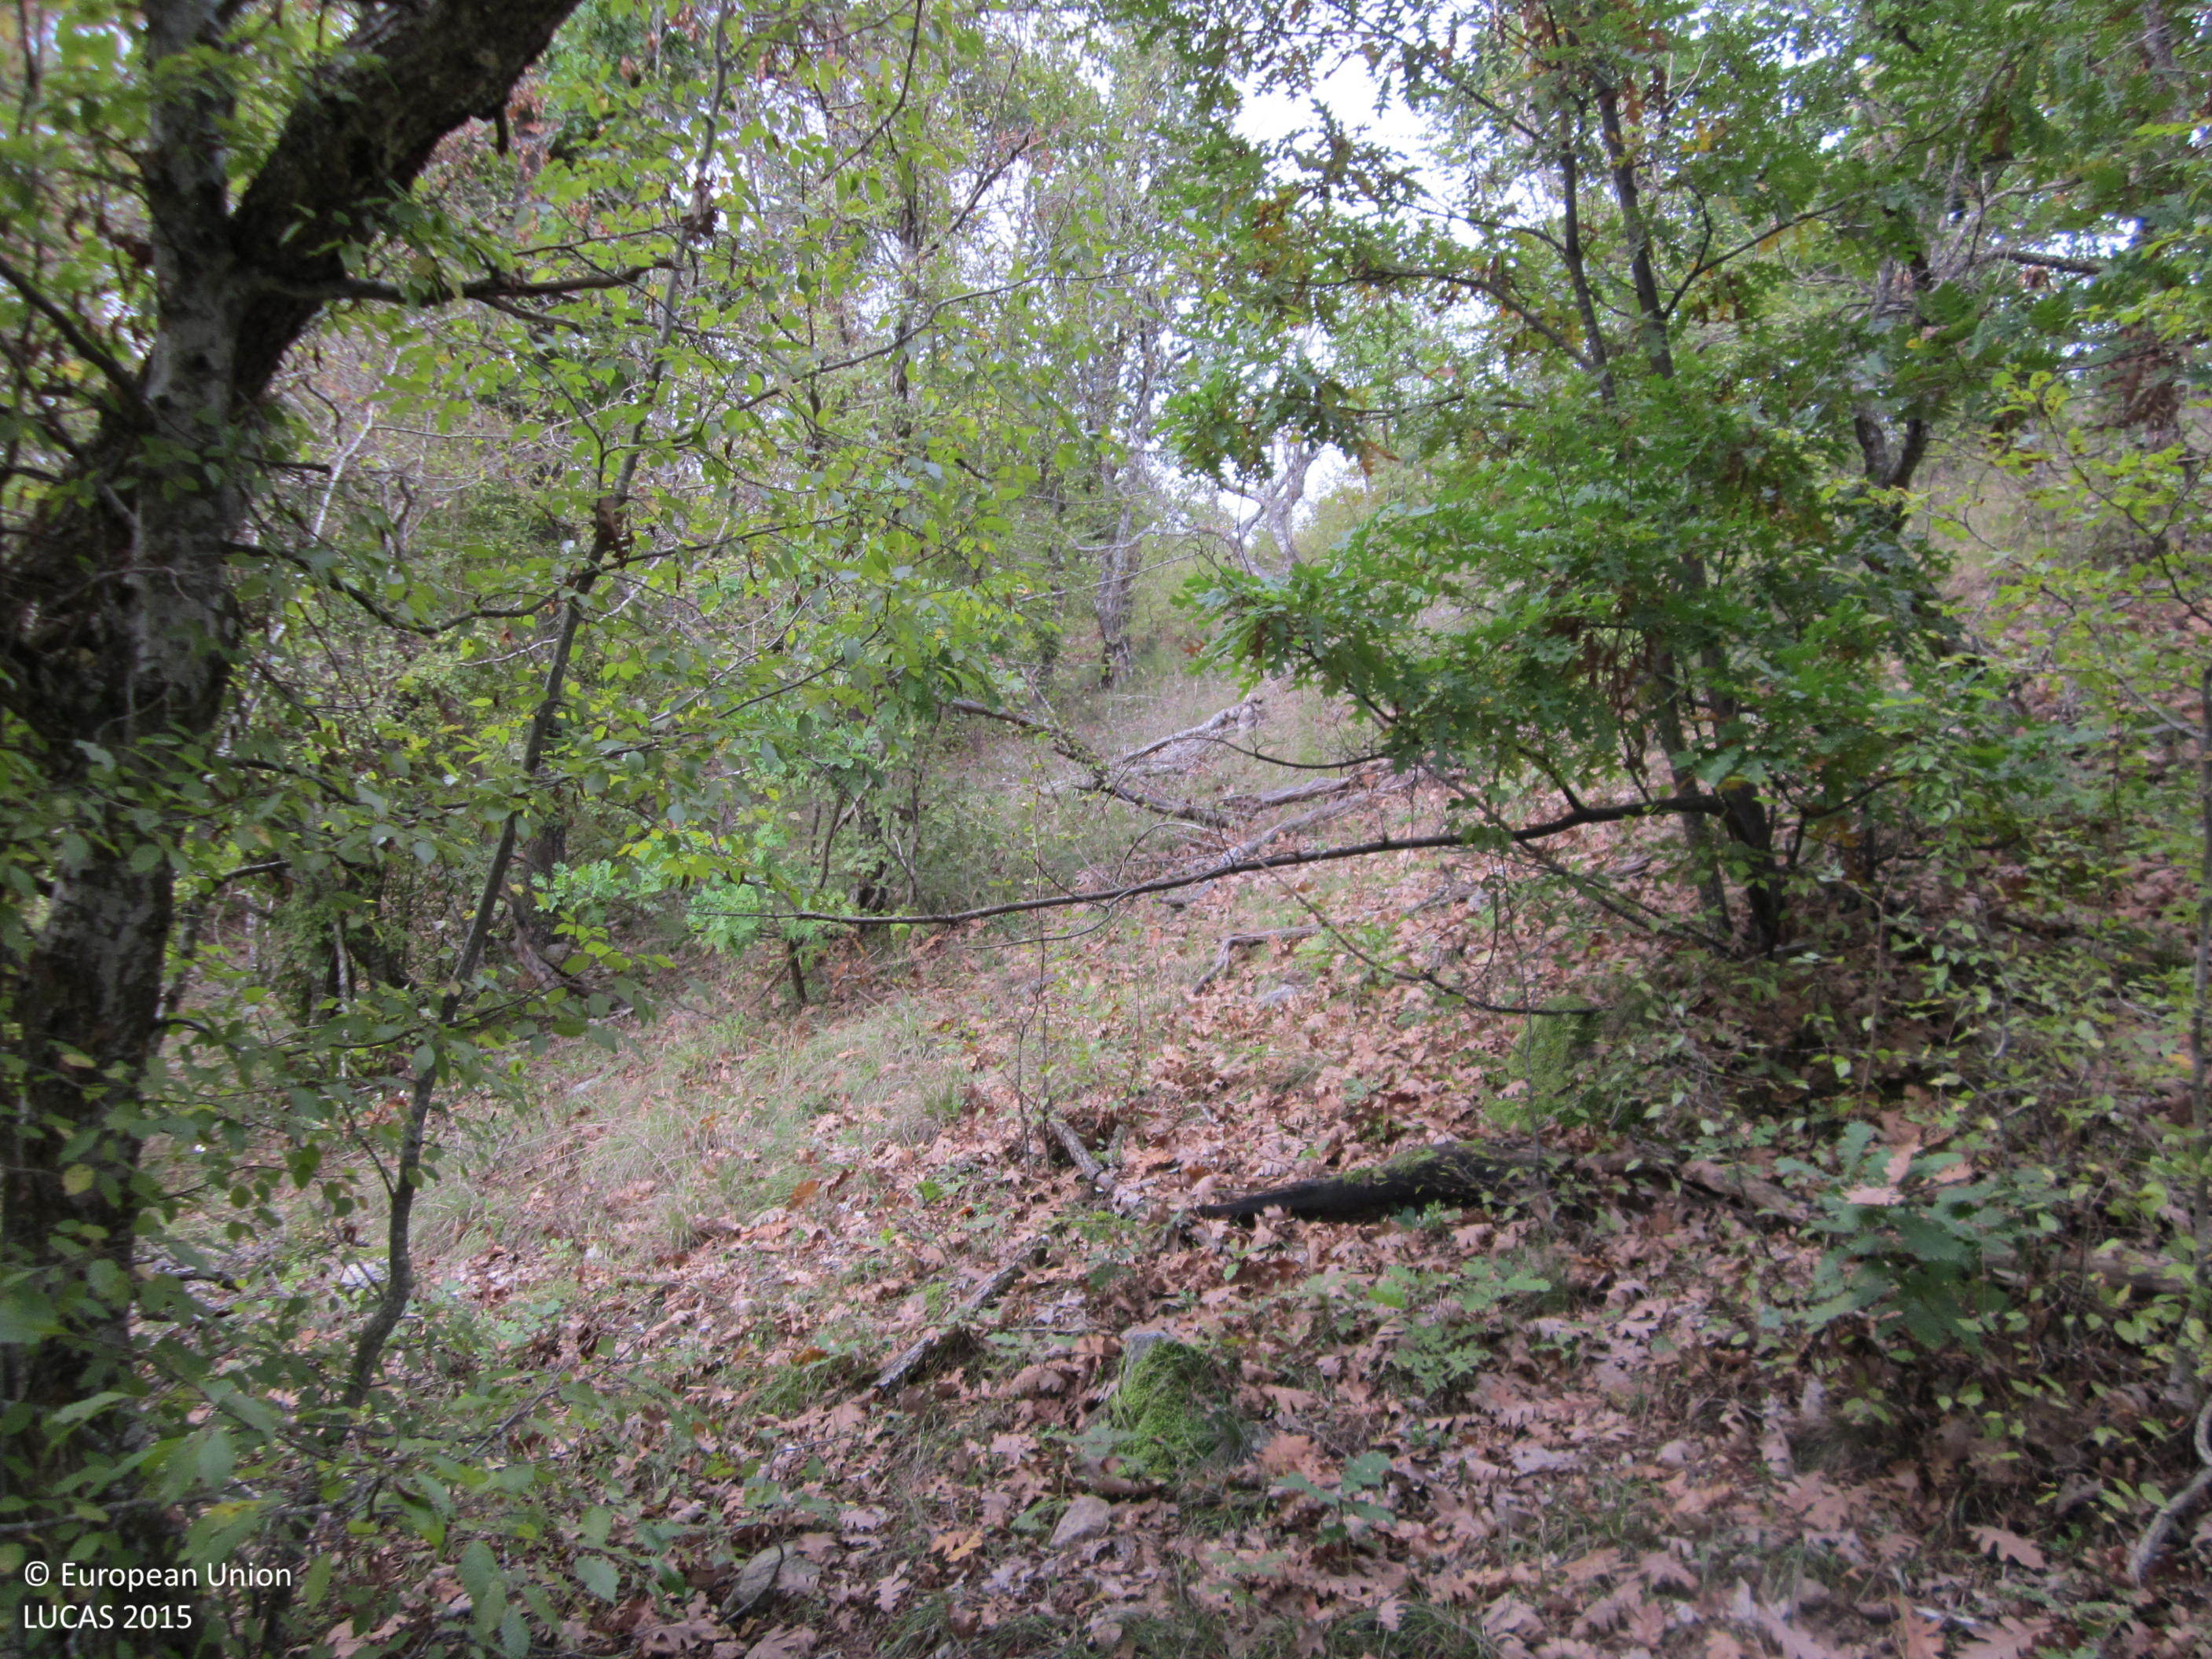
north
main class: Woodland
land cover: Broadleaved woodland
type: mesophytic deciduous forest
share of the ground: > 75 %
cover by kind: broadleaved forest trees 80 %, shrubs 10 %, herbaceous plants 10 %
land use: Forestry
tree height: > 5 m
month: October
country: BG
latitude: 42.2332
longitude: 27.2284
